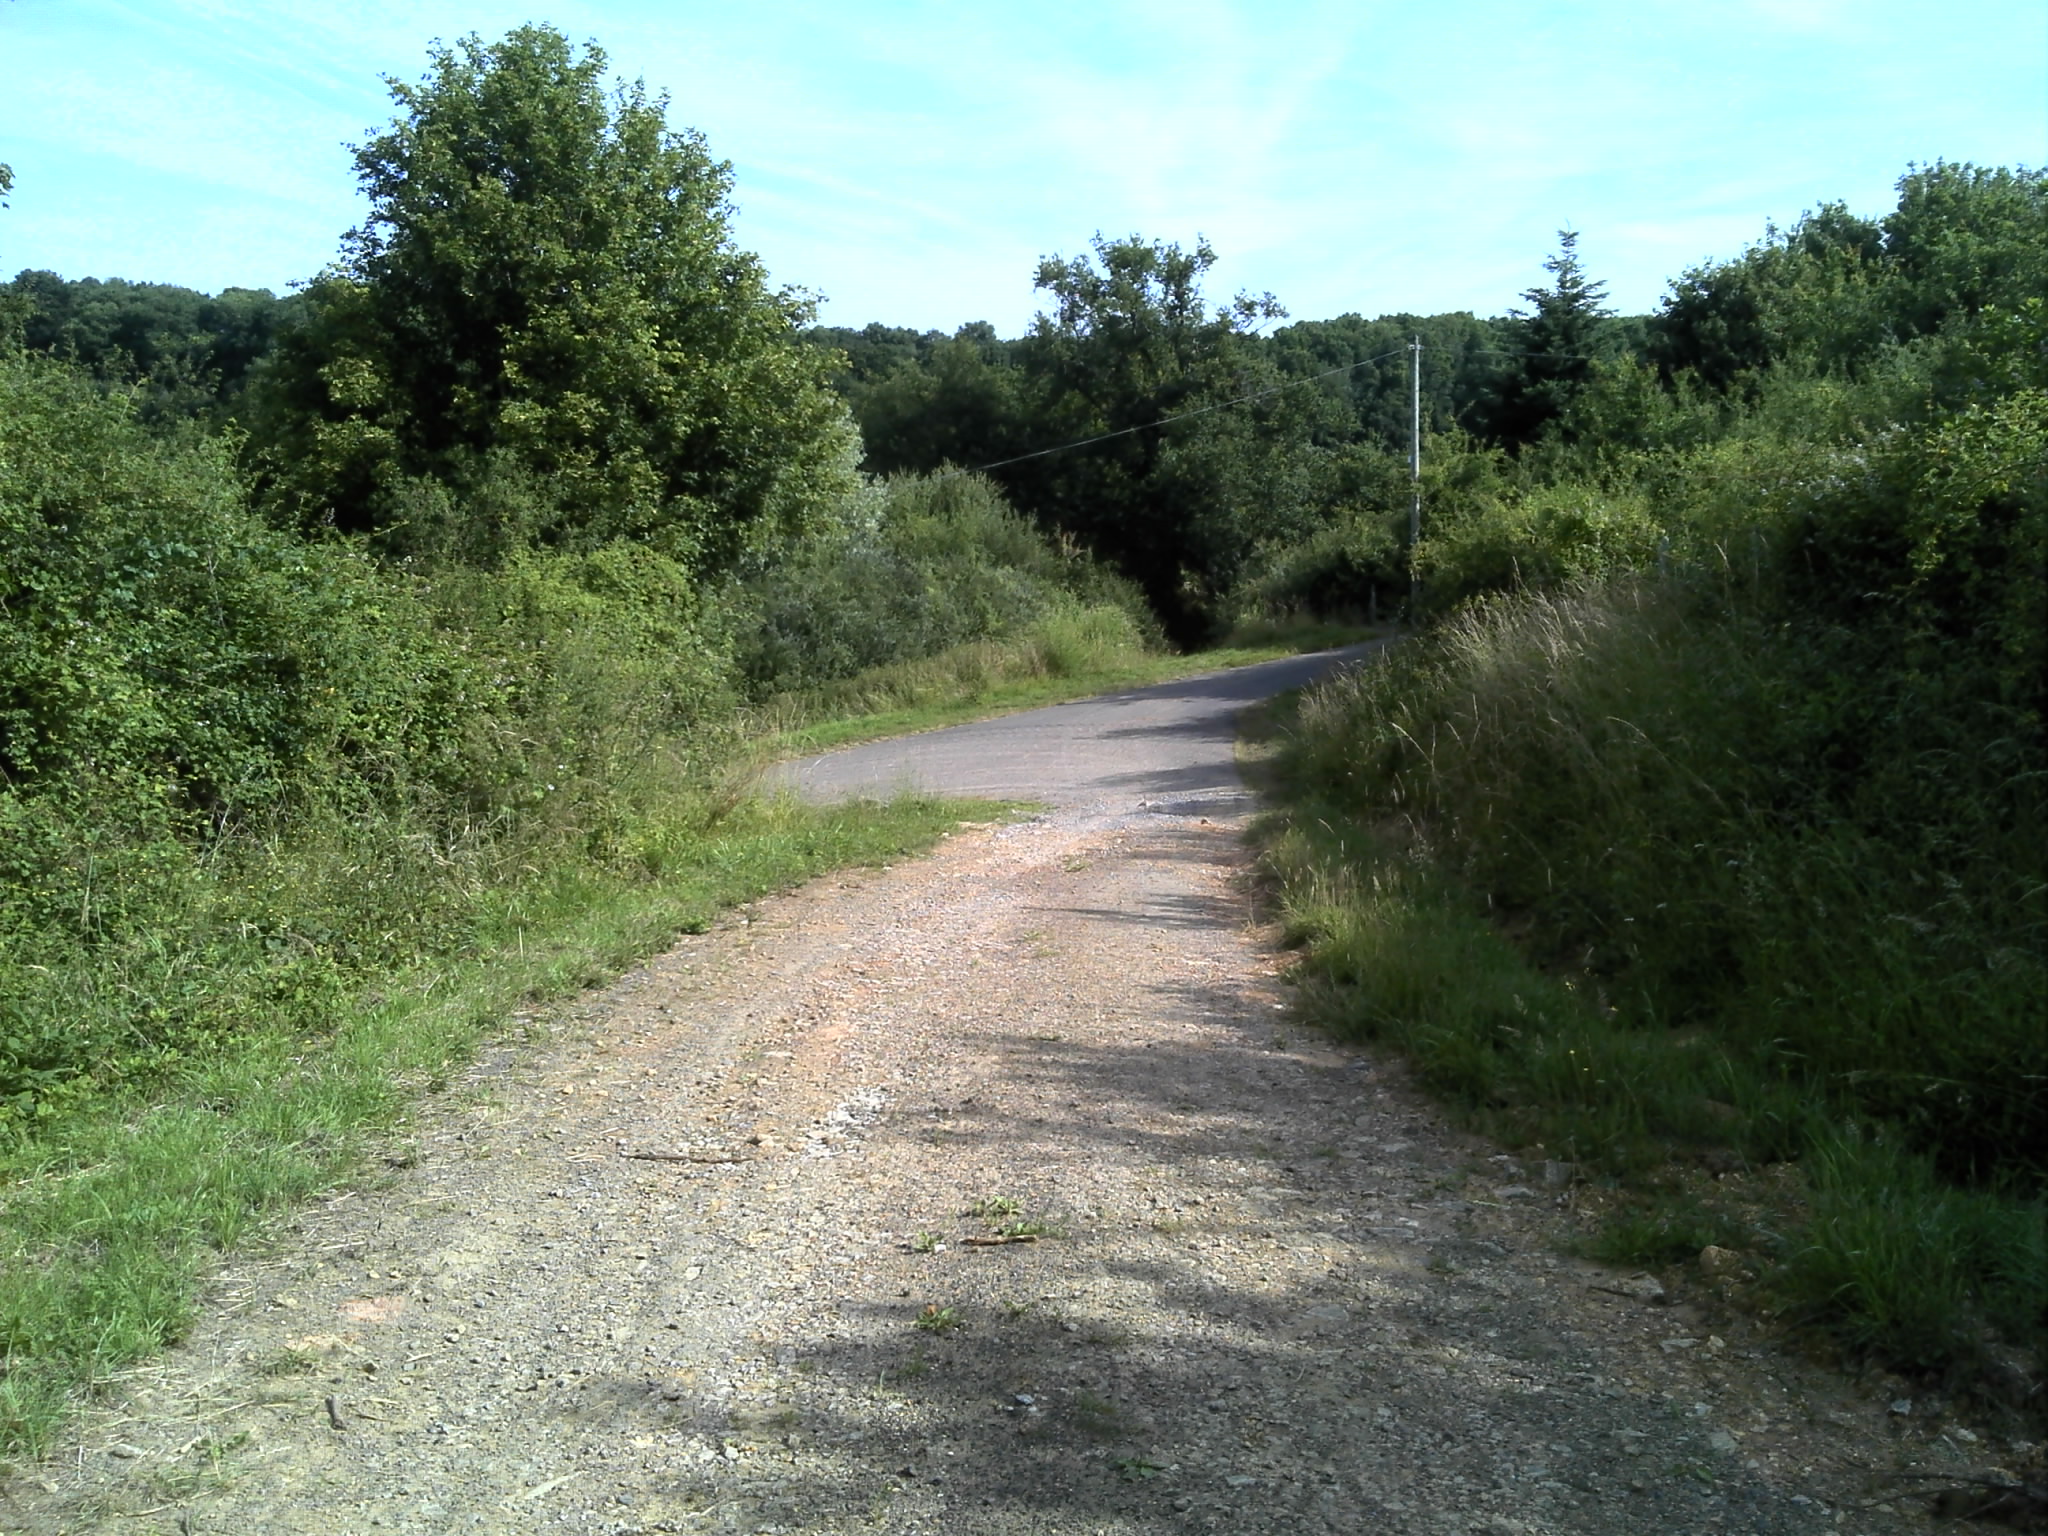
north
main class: Woodland
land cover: Broadleaved woodland
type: mesophytic deciduous forest
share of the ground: > 75 %
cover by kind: broadleaved forest trees 50 %, shrubs 50 %
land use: Semi-natural and natural areas not in use
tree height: < 5 m
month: June
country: FR
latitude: 46.5575
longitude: 1.5241
